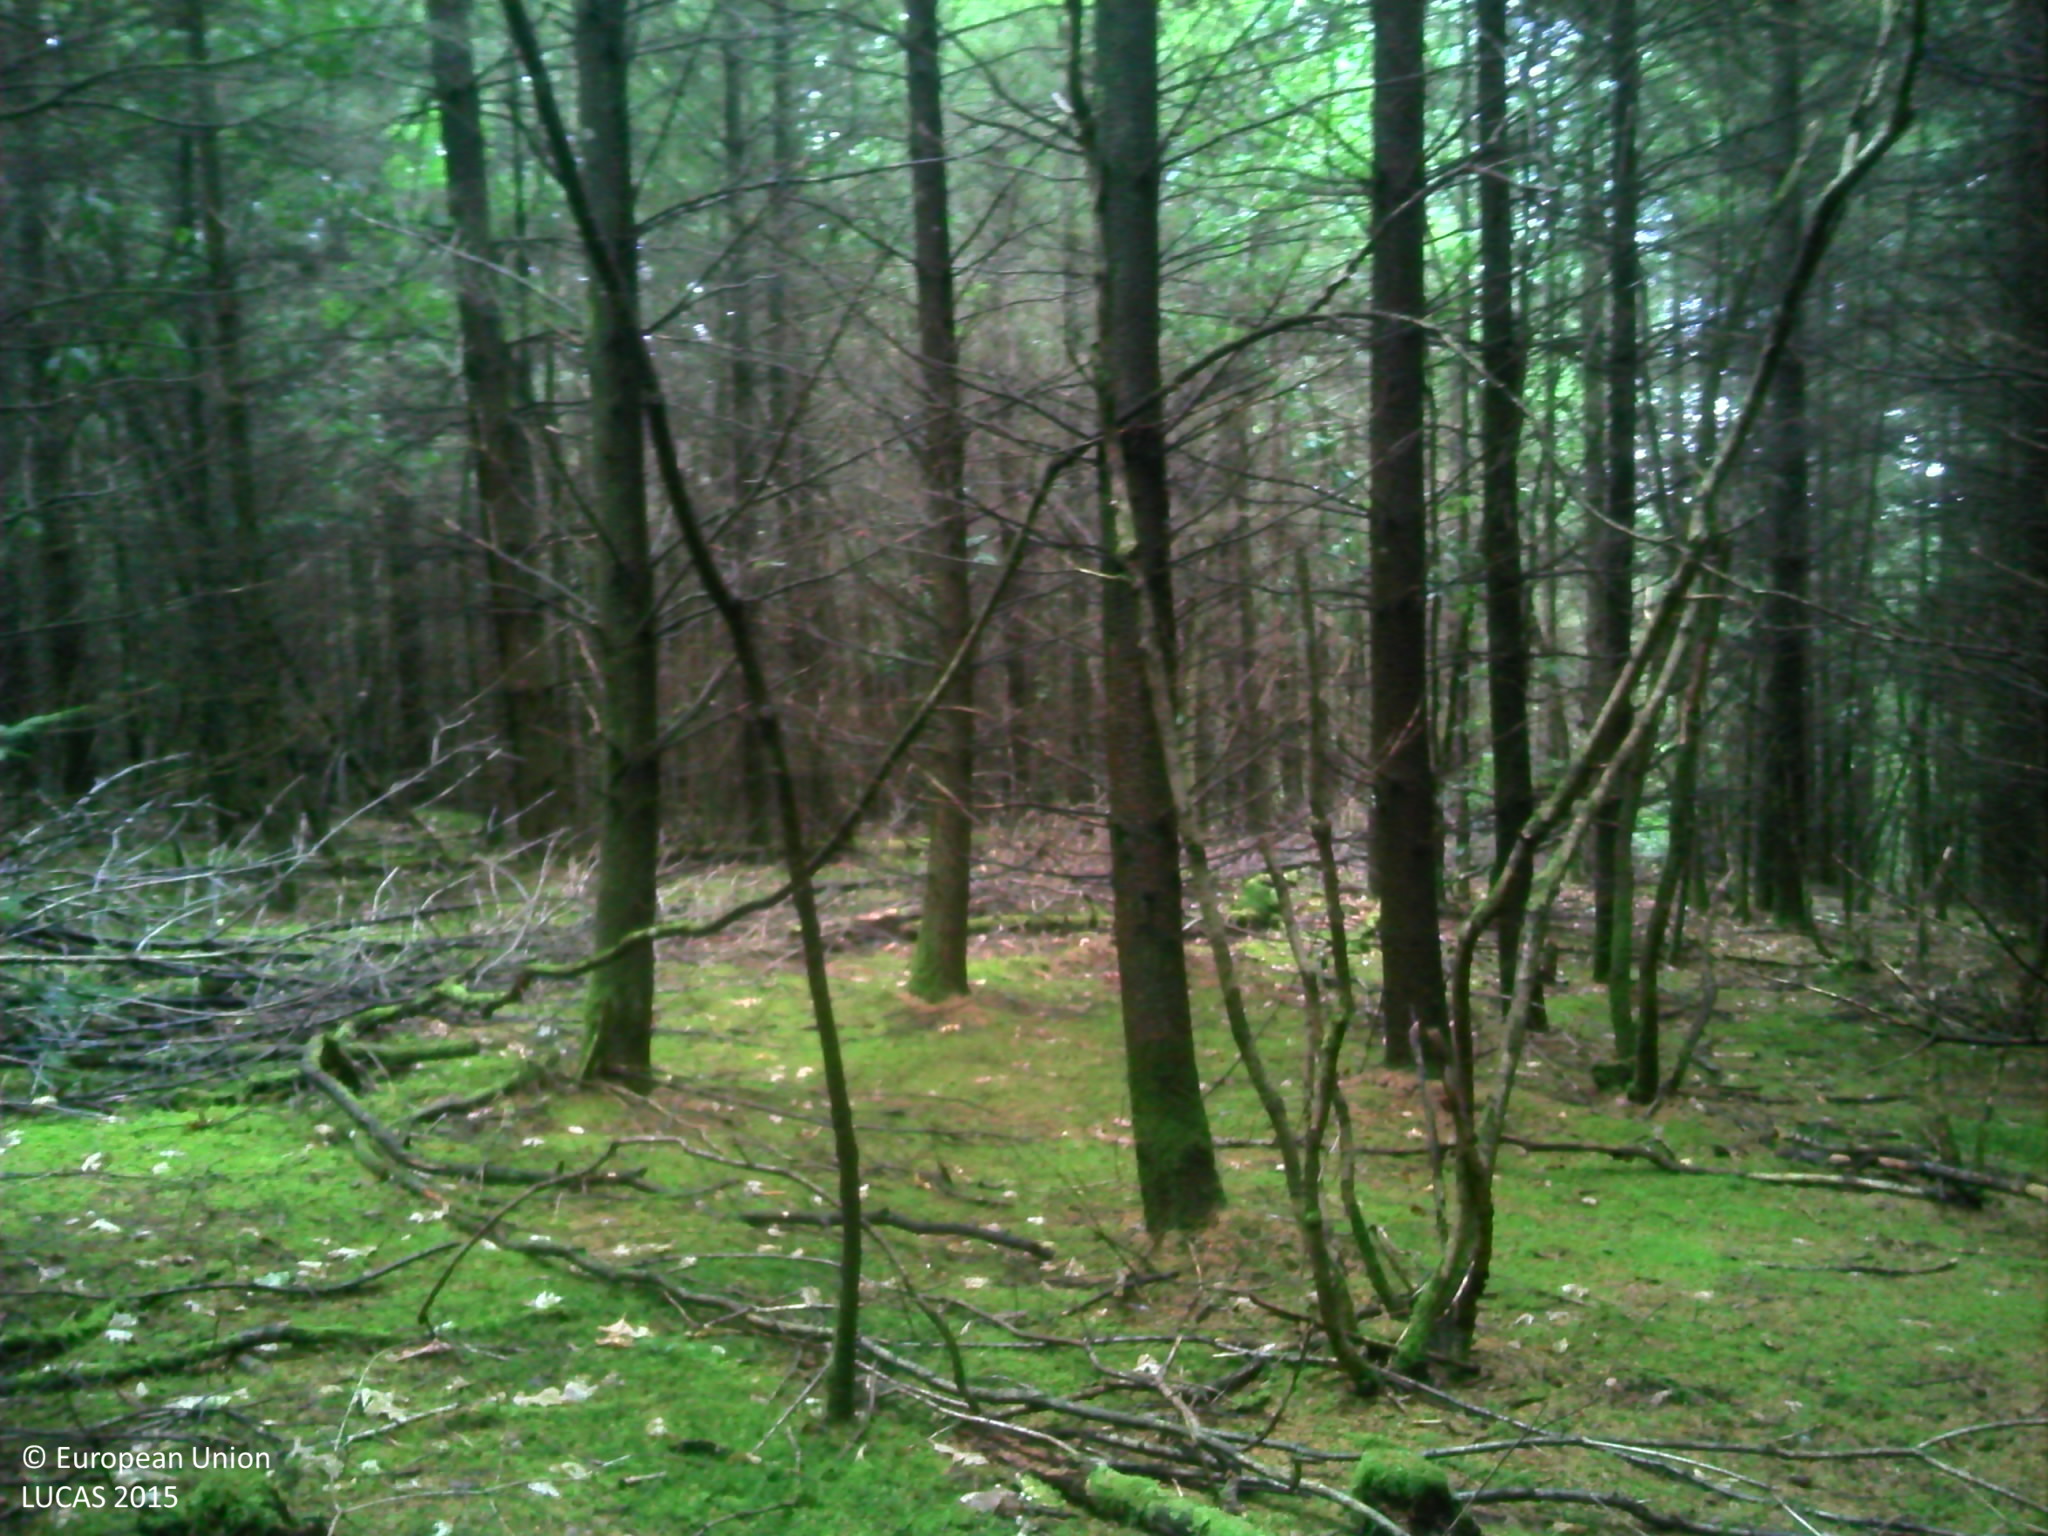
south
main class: Woodland
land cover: Other coniferous woodland
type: exotic forest
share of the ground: > 75 %
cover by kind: coniferous forest trees 90 %, herbaceous plants 10 %
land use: Forestry
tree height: > 5 m
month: July
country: FR
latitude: 46.4800
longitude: 4.4916
